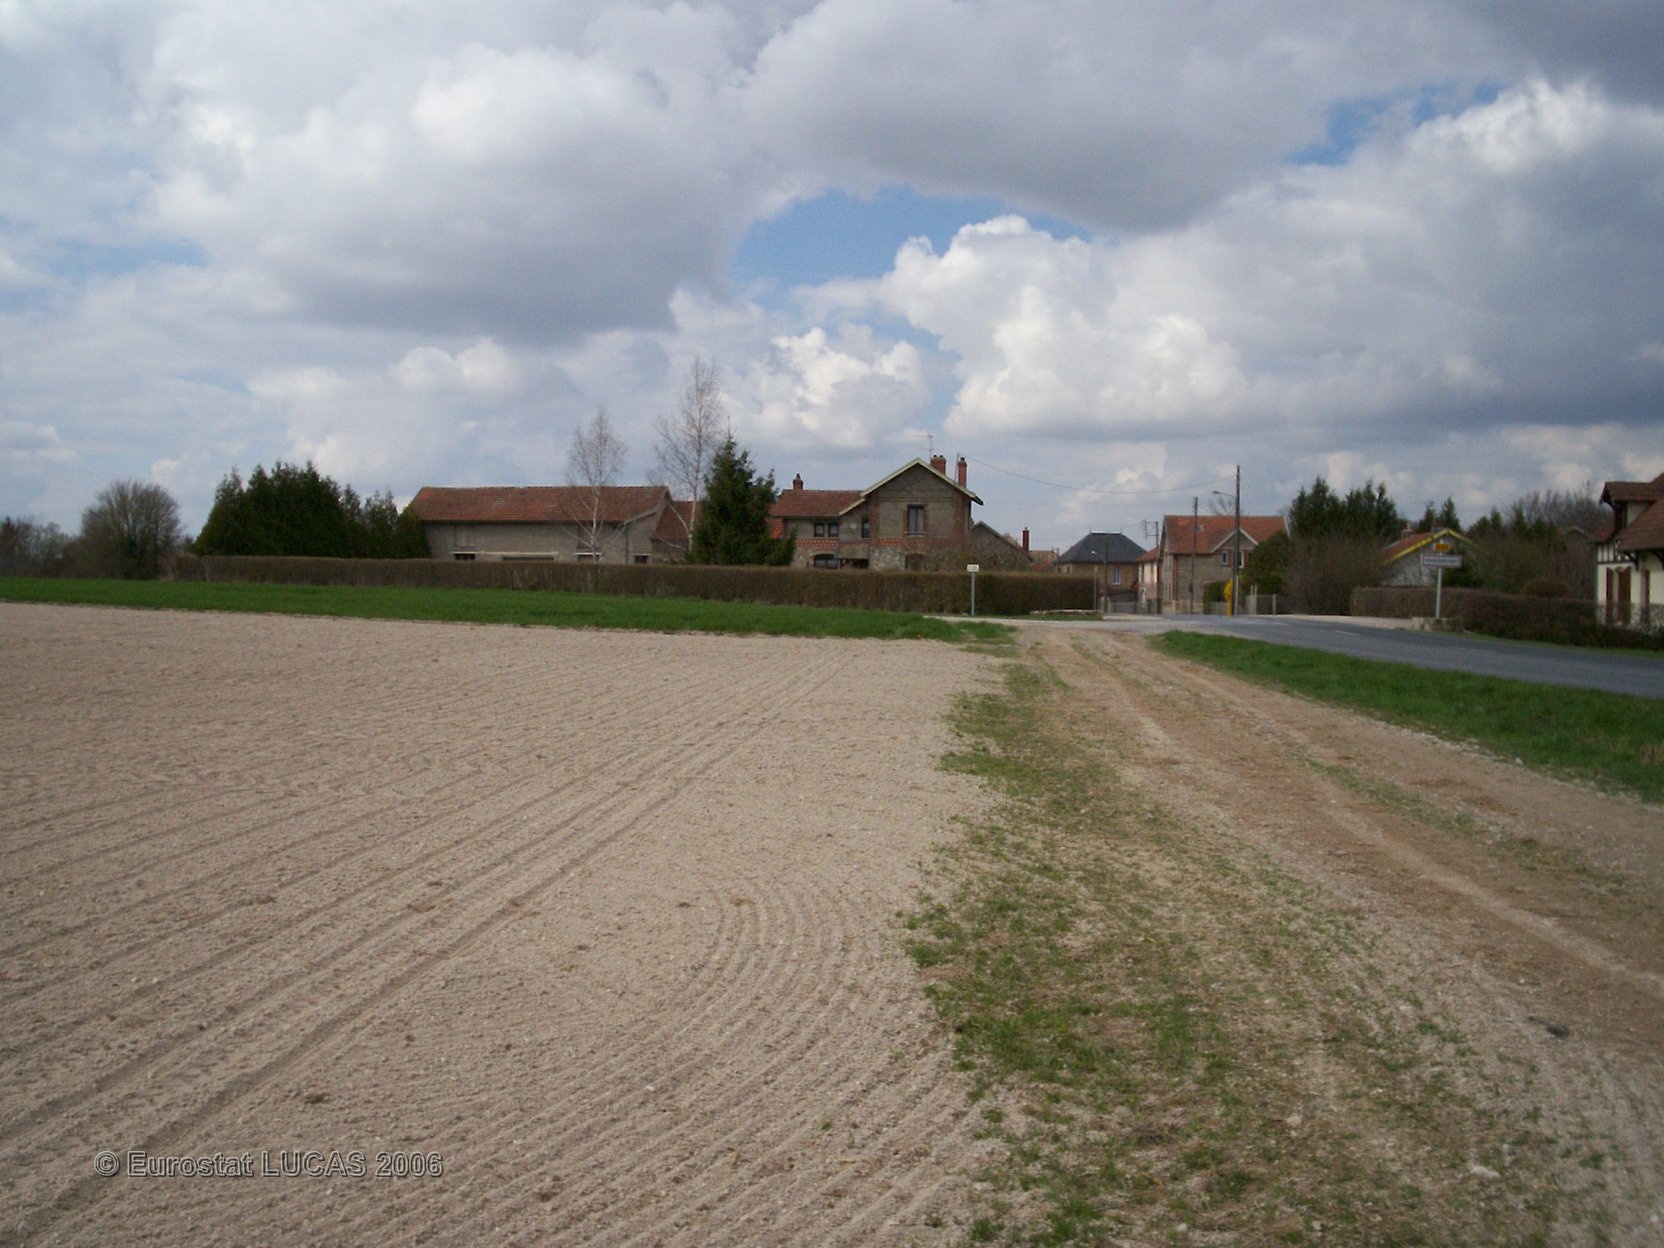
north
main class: Cropland
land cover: Sugar beet
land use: Agriculture (excluding fallow land and kitchen gardens)
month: June
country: FR
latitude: 49.2178
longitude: 4.4085
